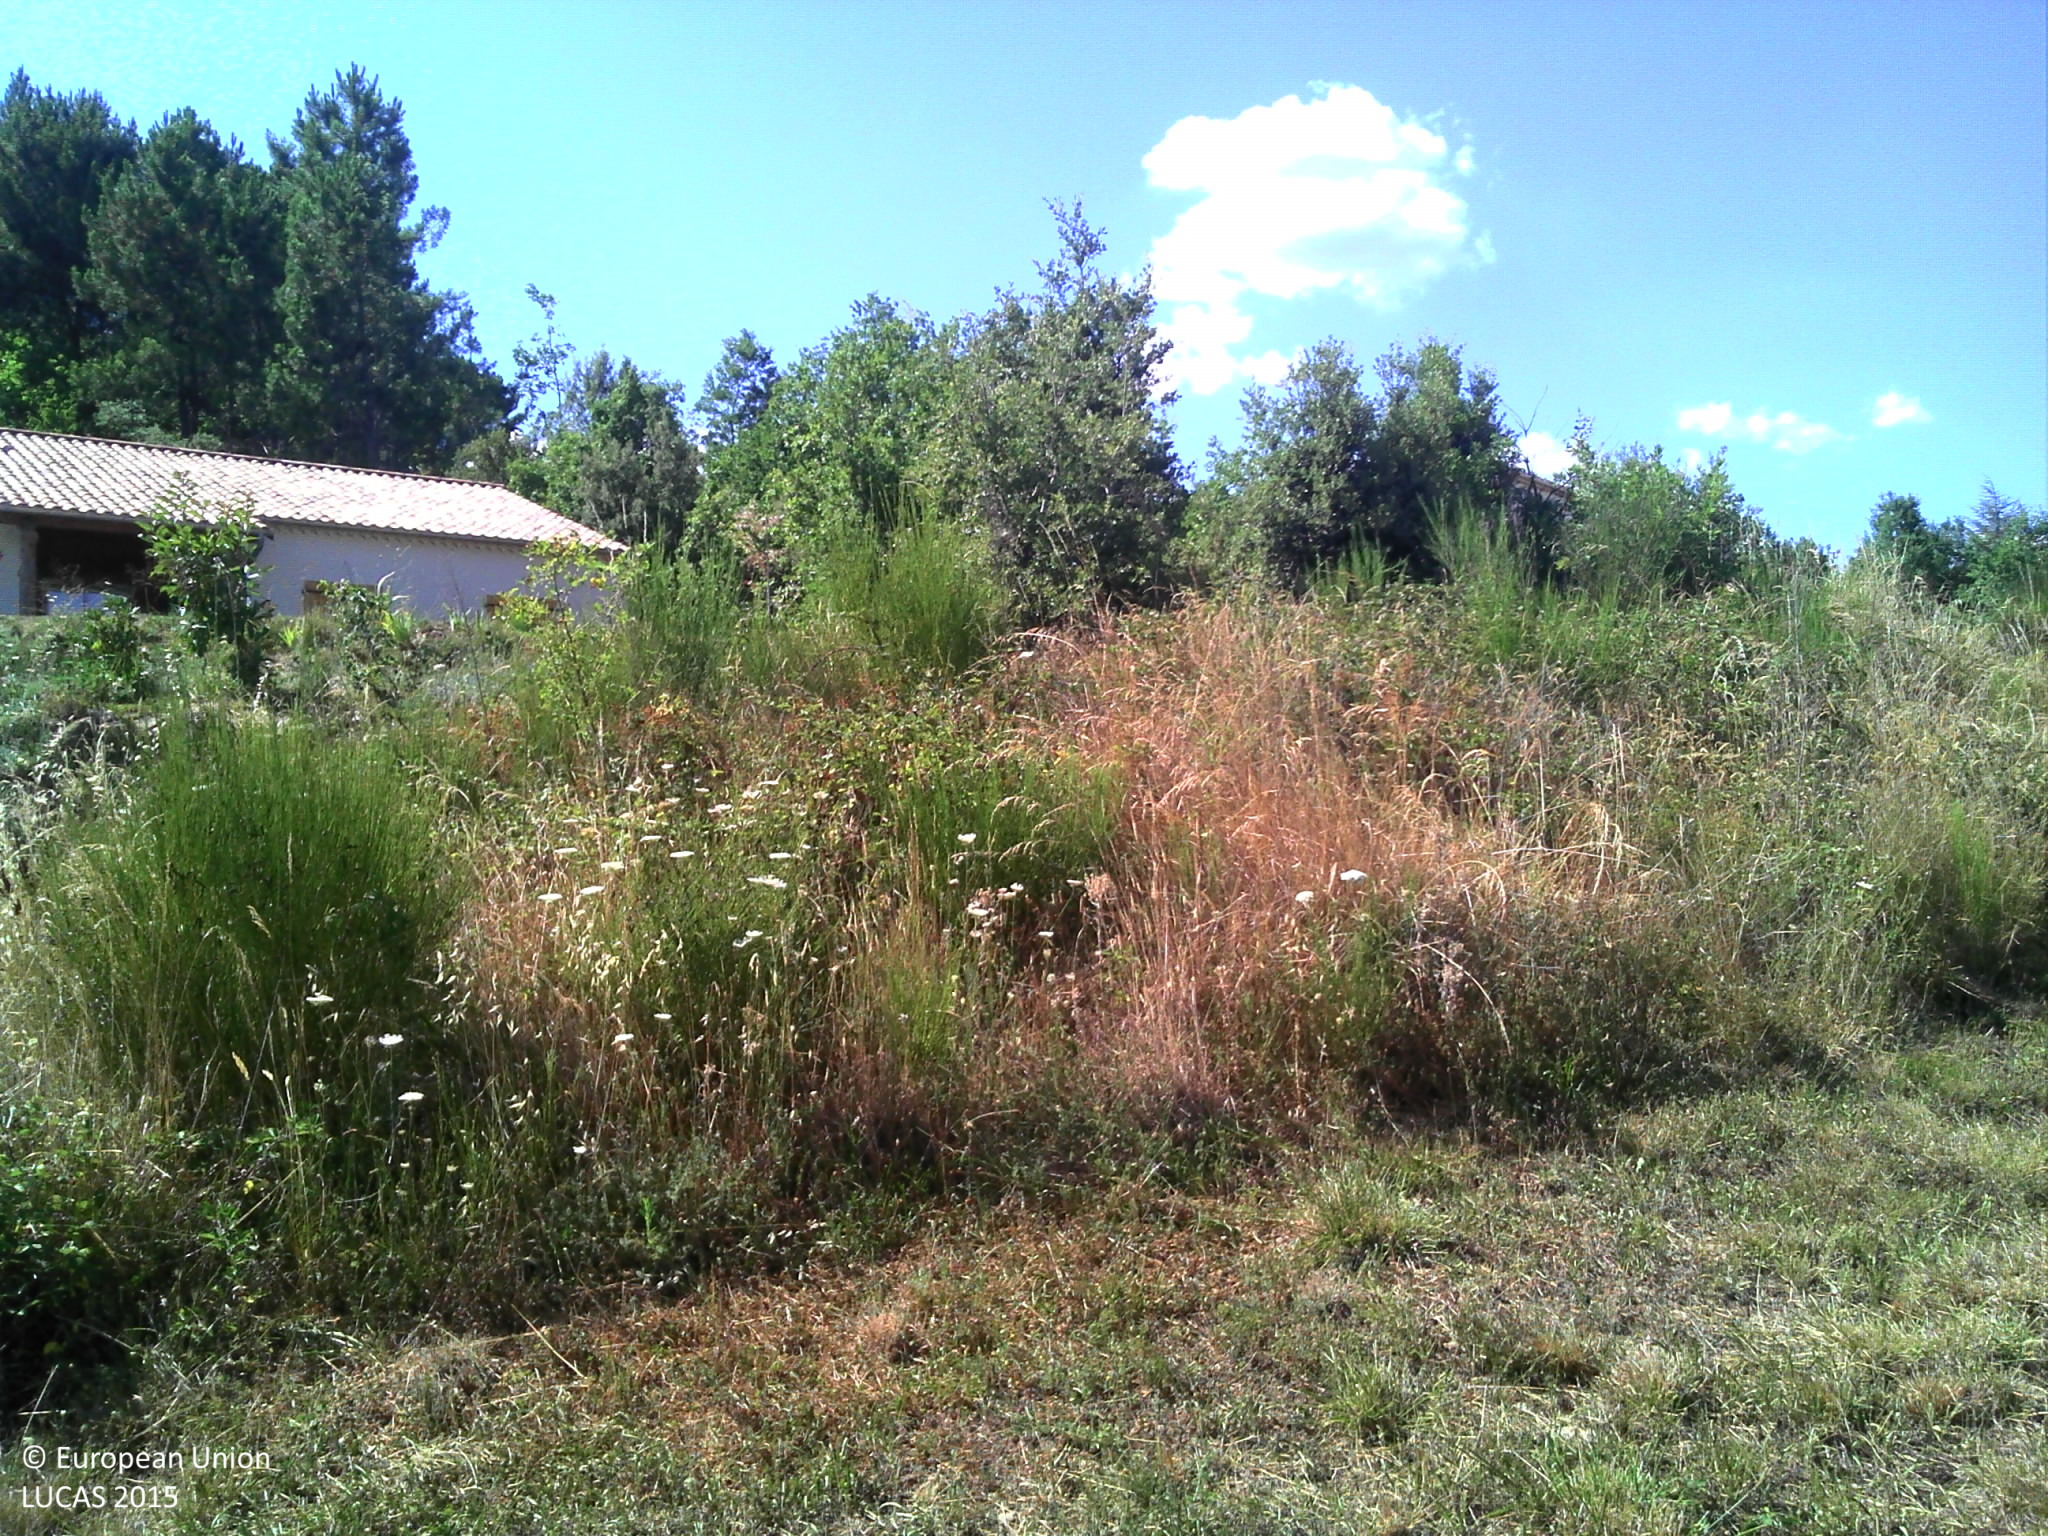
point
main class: Grassland
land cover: Grassland with sparse tree/shrub cover
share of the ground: > 75 %
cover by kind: herbaceous plants 95 %, broadleaved forest trees 5 %
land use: Residential
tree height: < 5 m
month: July
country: FR
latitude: 44.5349
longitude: 4.2552
